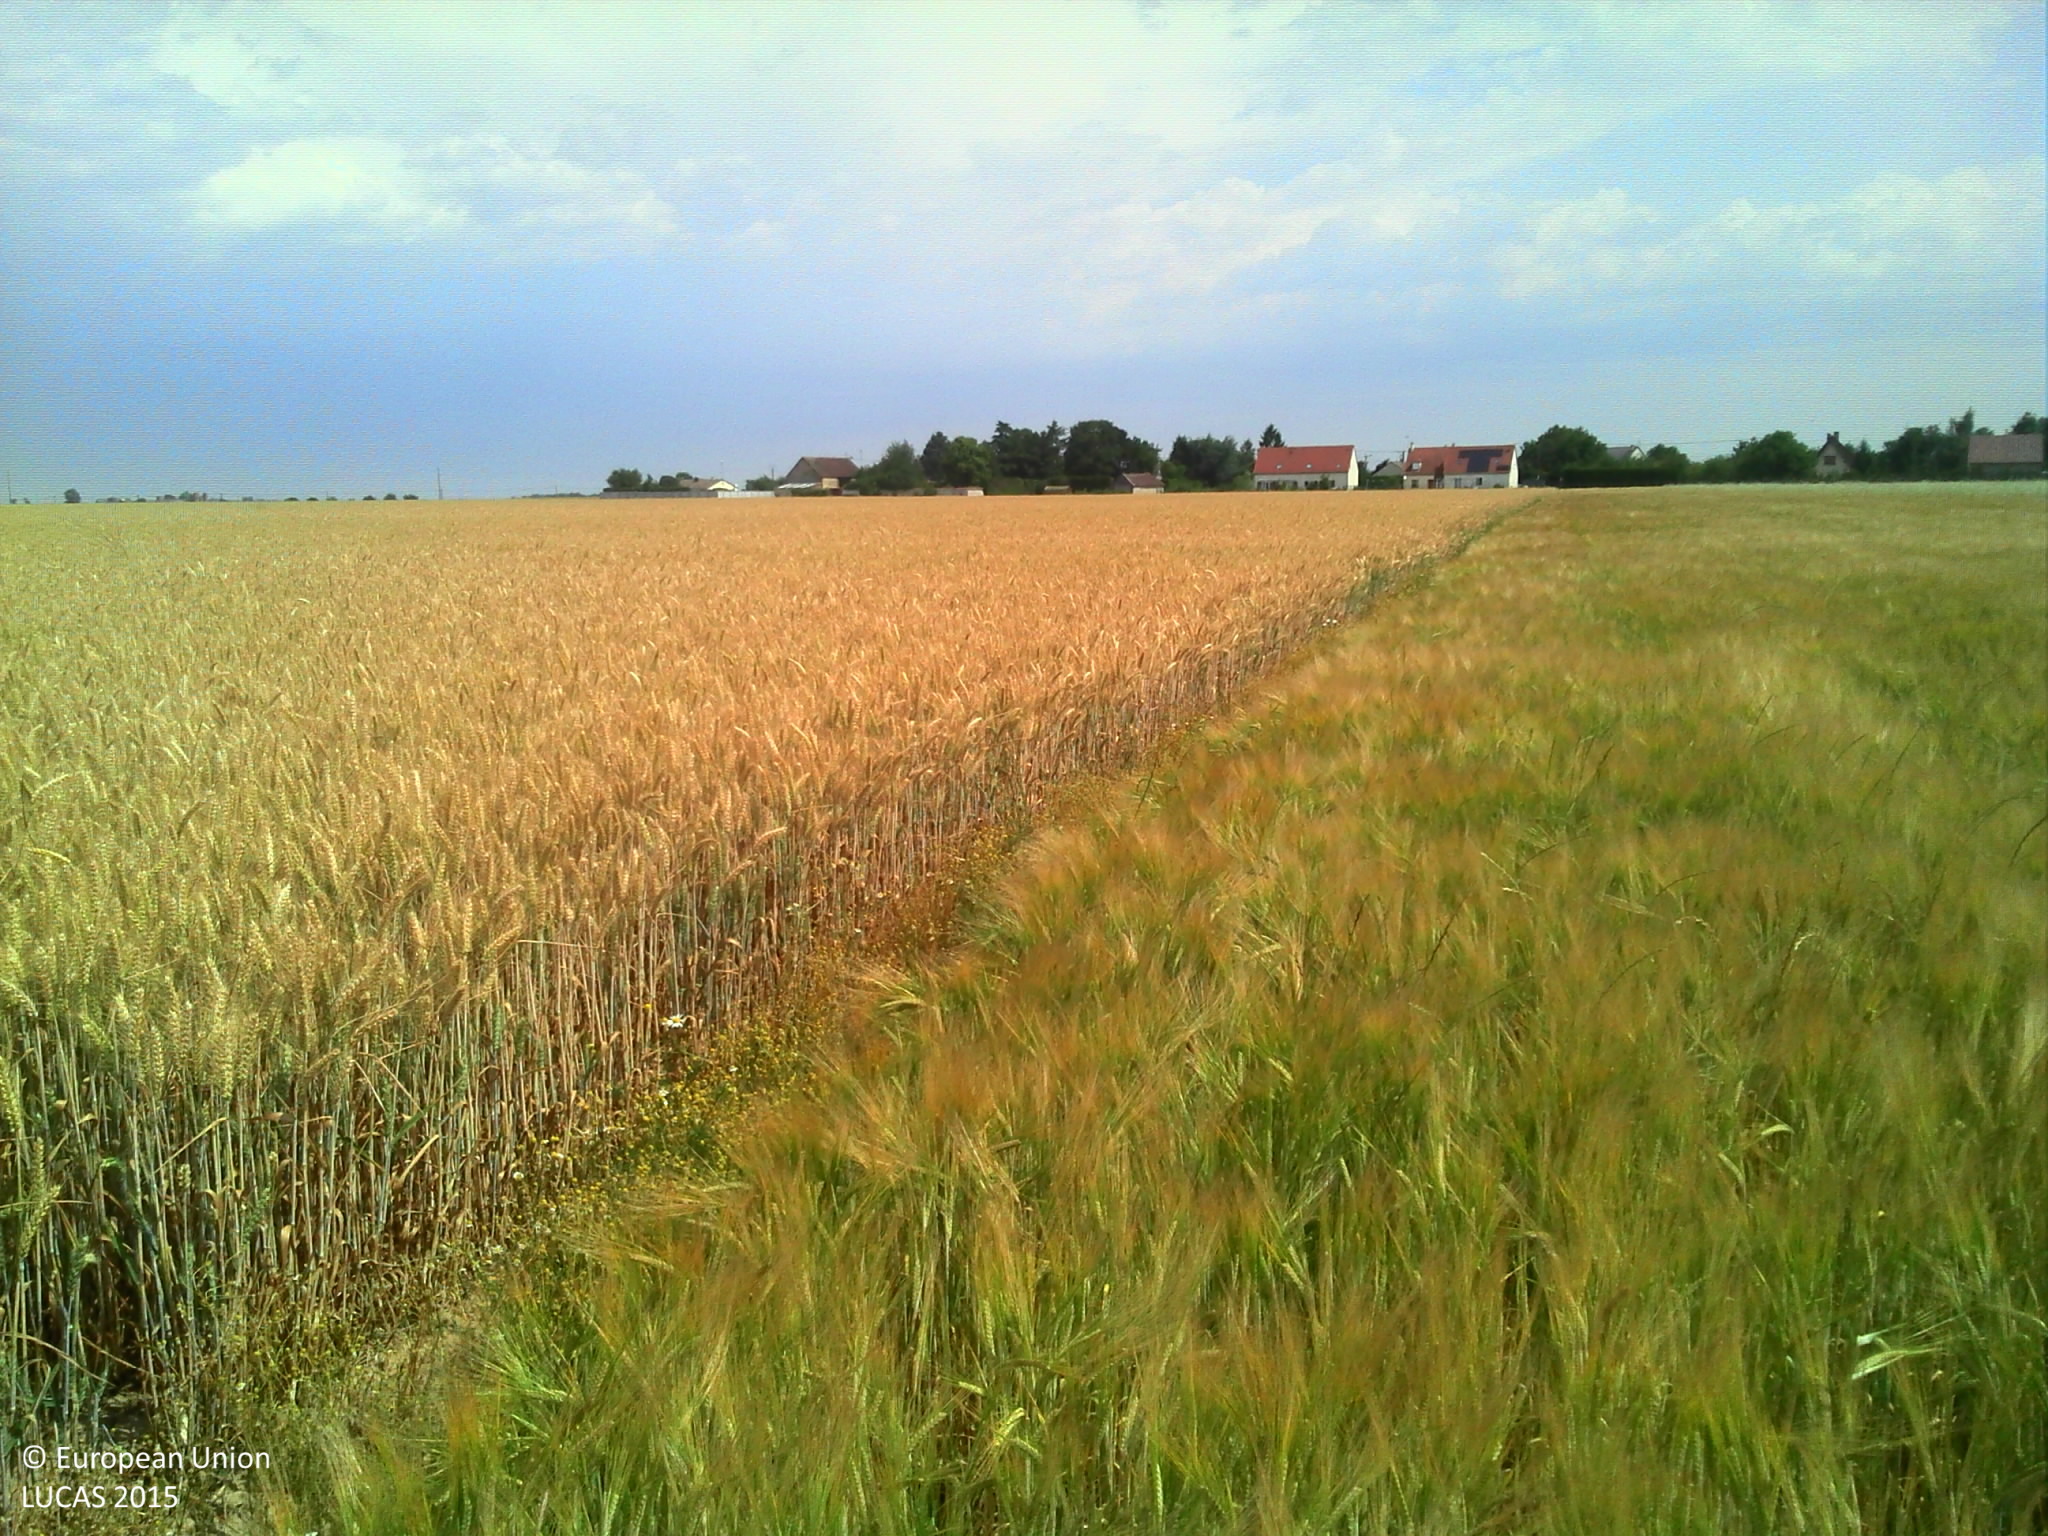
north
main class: Cropland
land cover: Triticale
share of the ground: > 75 %
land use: Agriculture (excluding fallow land and kitchen gardens)
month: July
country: FR
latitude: 48.8676
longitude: 1.2145
